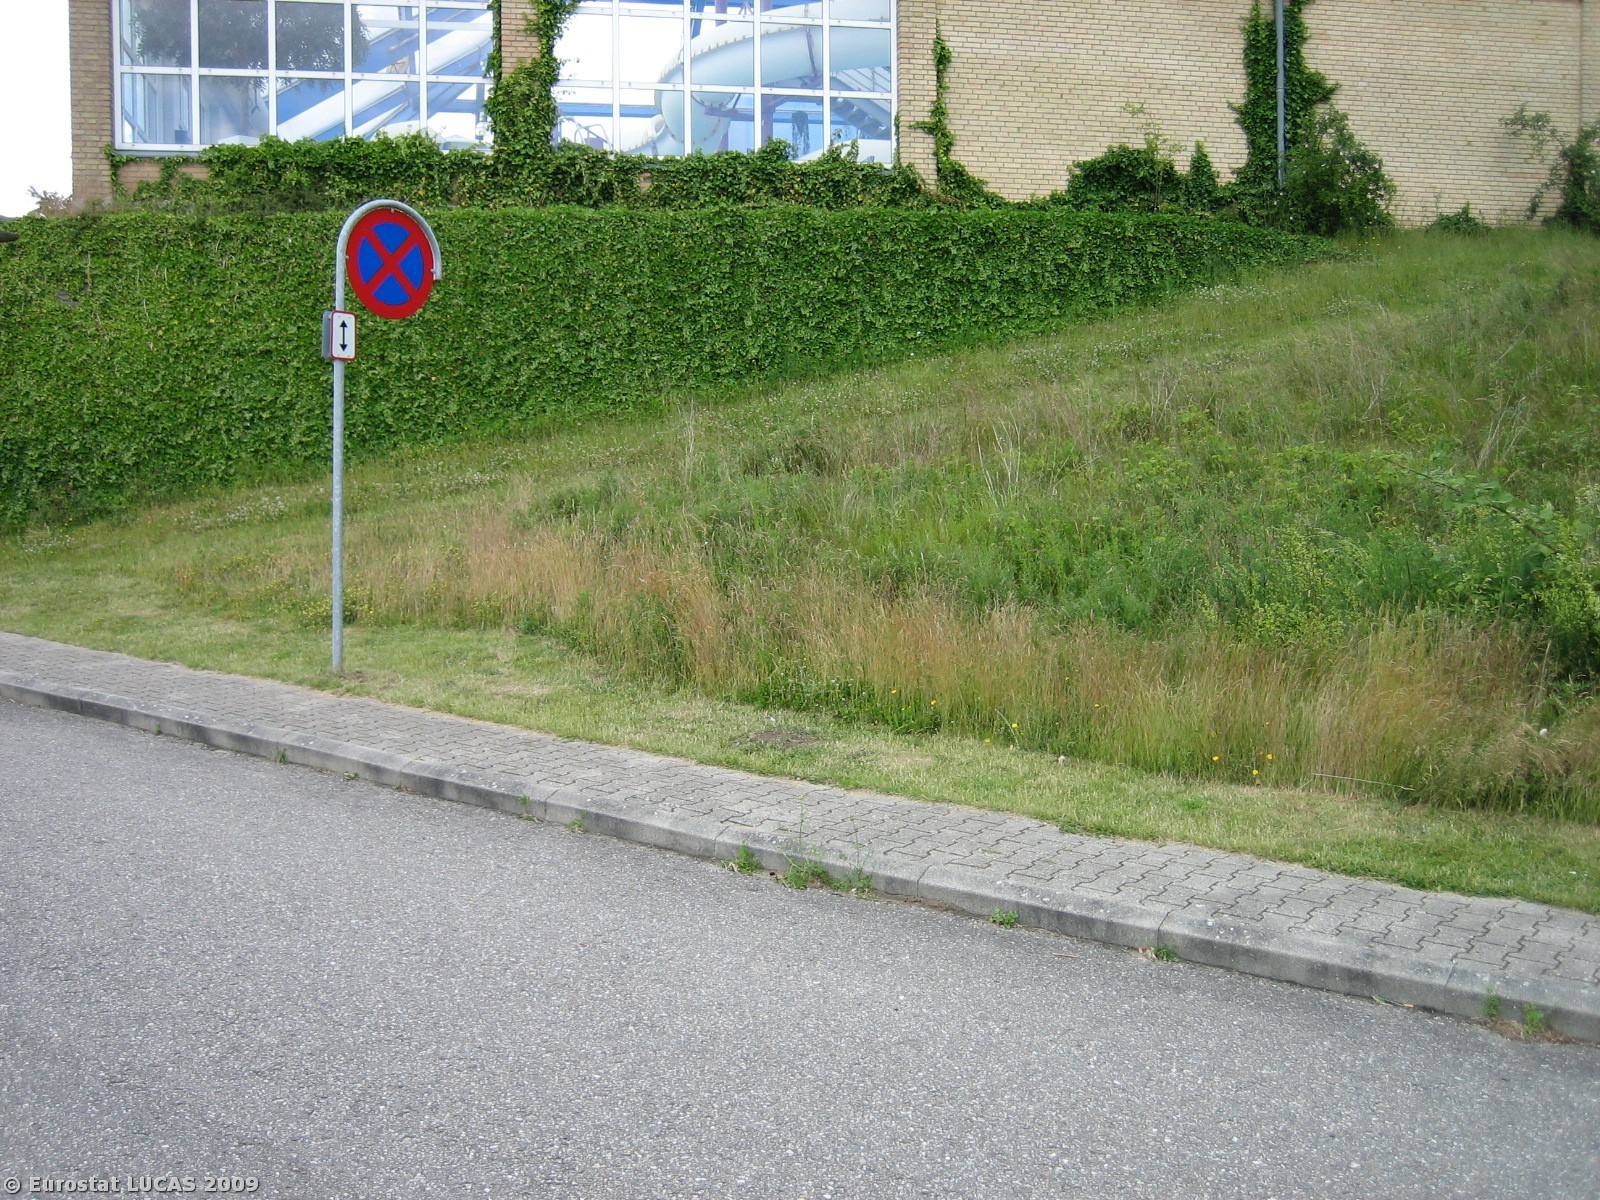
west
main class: Grassland
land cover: Grassland without tree/shrub cover
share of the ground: > 75 %
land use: Amenities, museums, leisure
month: June
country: DK
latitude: 55.5763
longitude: 9.7306
